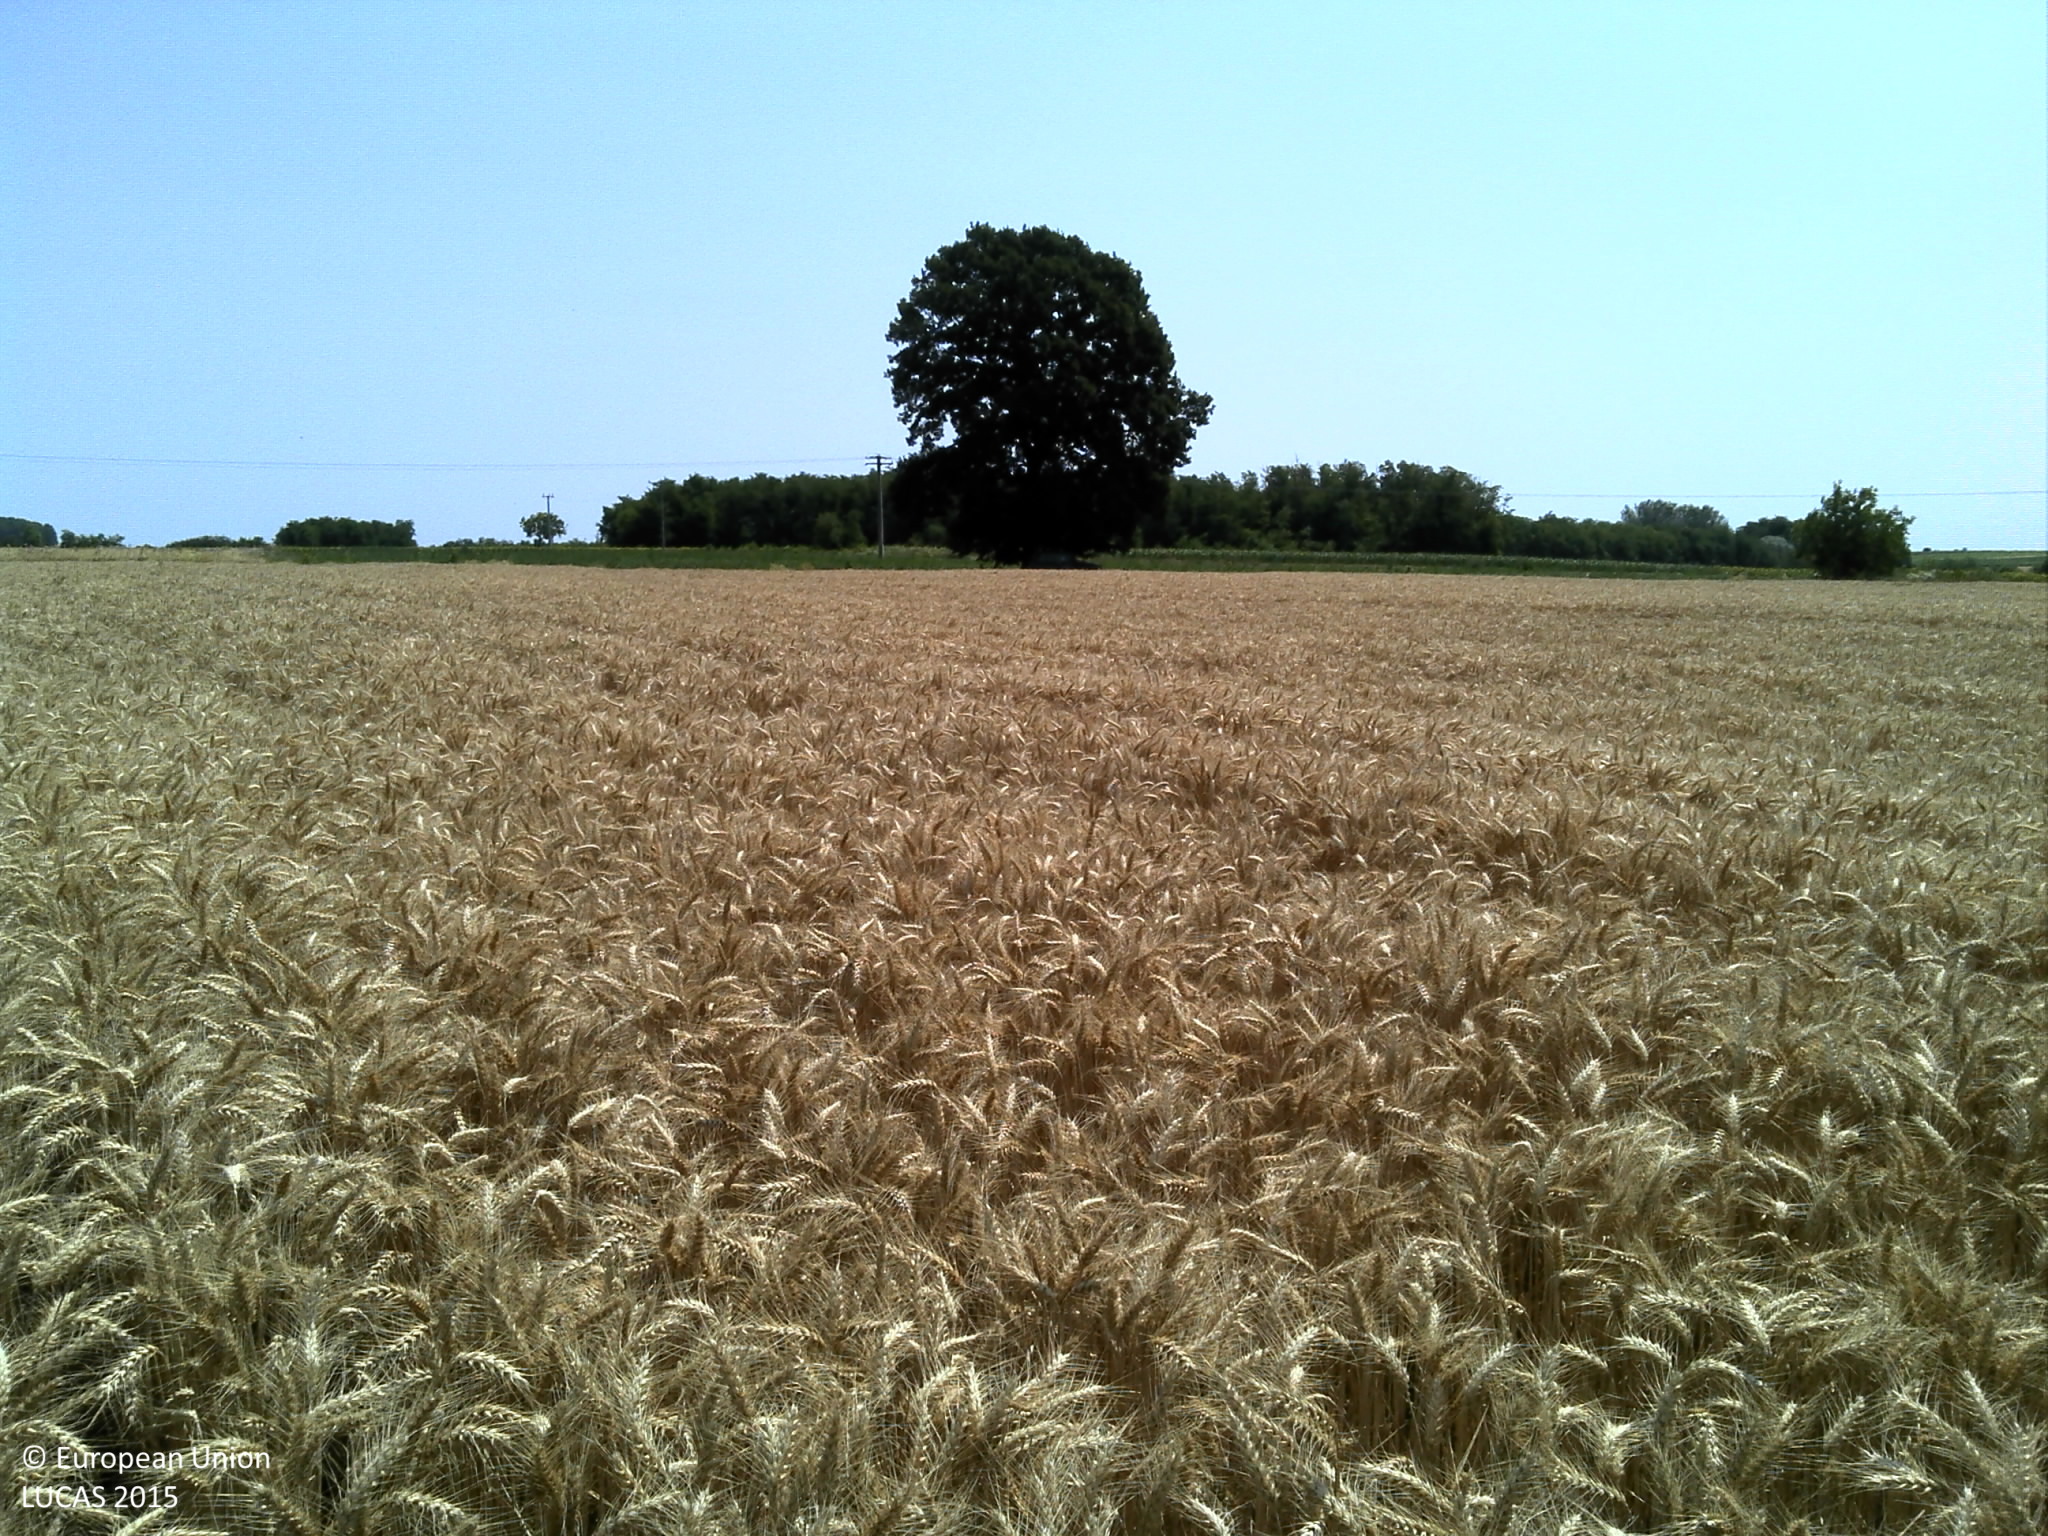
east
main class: Cropland
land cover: Common wheat
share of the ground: > 75 %
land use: Agriculture (excluding fallow land and kitchen gardens)
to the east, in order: Common wheat; Tracks; Soya; Electric lines; Tracks; Grass margins; Shrubland without tree cover; Maize
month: July
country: HR
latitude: 45.3010
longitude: 18.5630
